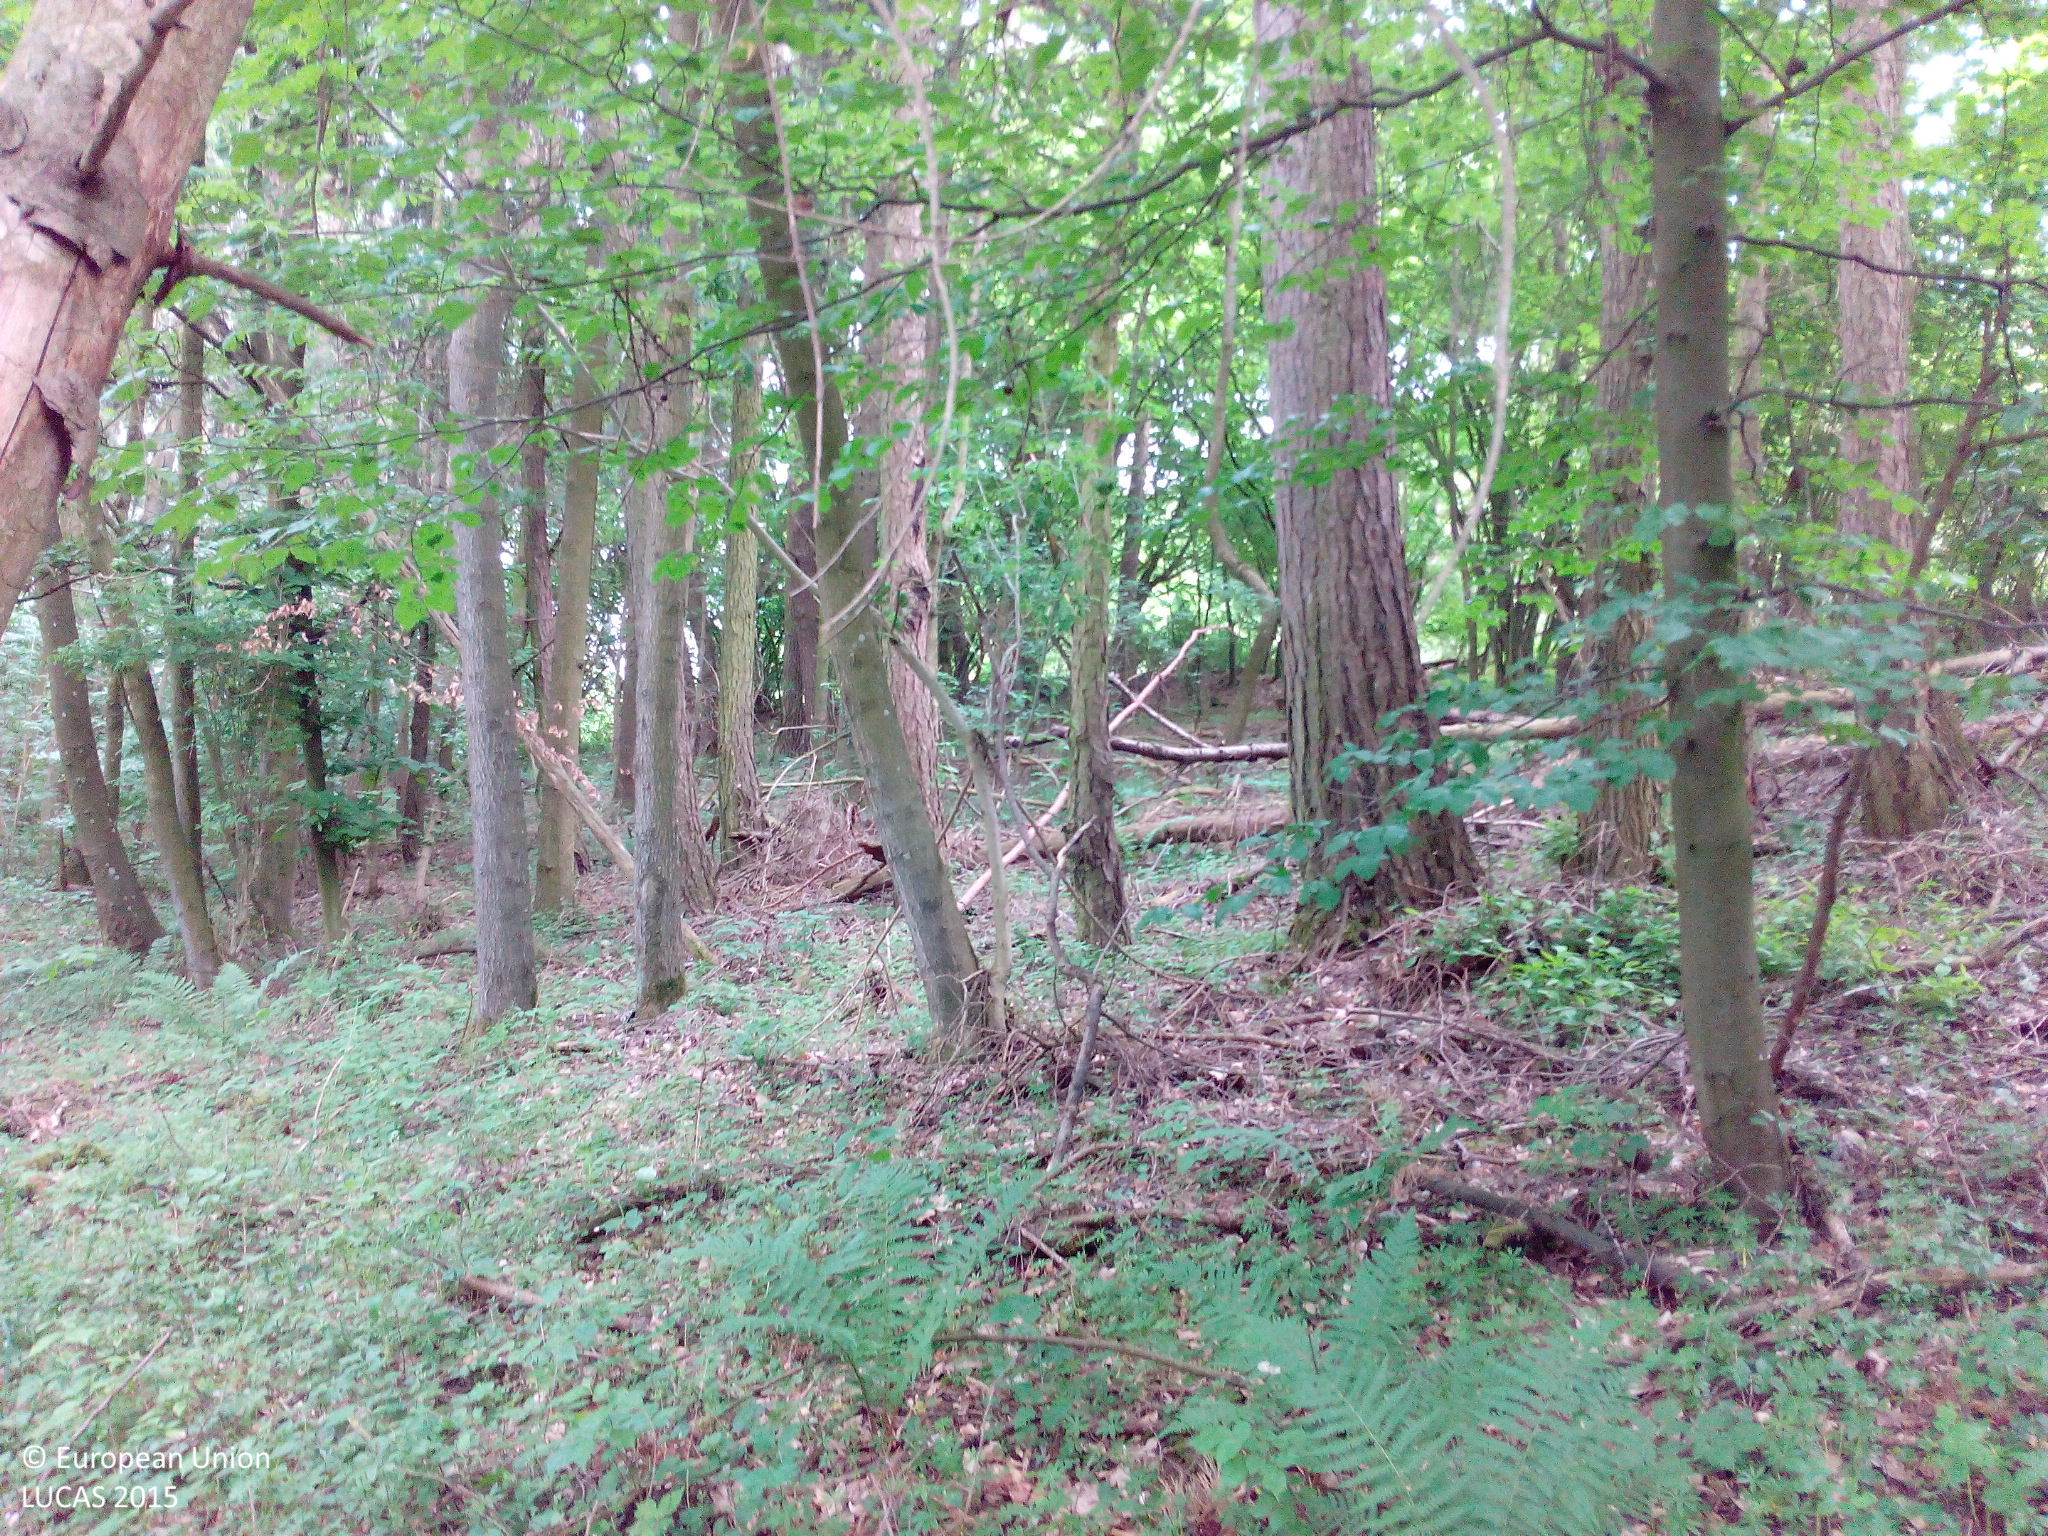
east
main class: Woodland
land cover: Pine dominated mixed woodland
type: hemiboreal forest and nemoral coniferous forest and mixed broadleaved-coniferous forest
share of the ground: > 75 %
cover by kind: coniferous forest trees 60 %, broadleaved forest trees 30 %, shrubs 5 %, herbaceous plants 5 %
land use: Semi-natural and natural areas not in use
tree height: > 5 m
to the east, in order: Pine dominated mixed woodland; Grassland without tree/shrub cover; Lines of trees; Paved roads, cycling and walking lanes; Grass margins; Ditches and canals; Abandoned hedges; Grassland without tree/shrub cover; Pine dominated mixed woodland
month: May
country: DE
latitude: 49.3720
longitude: 9.1878
